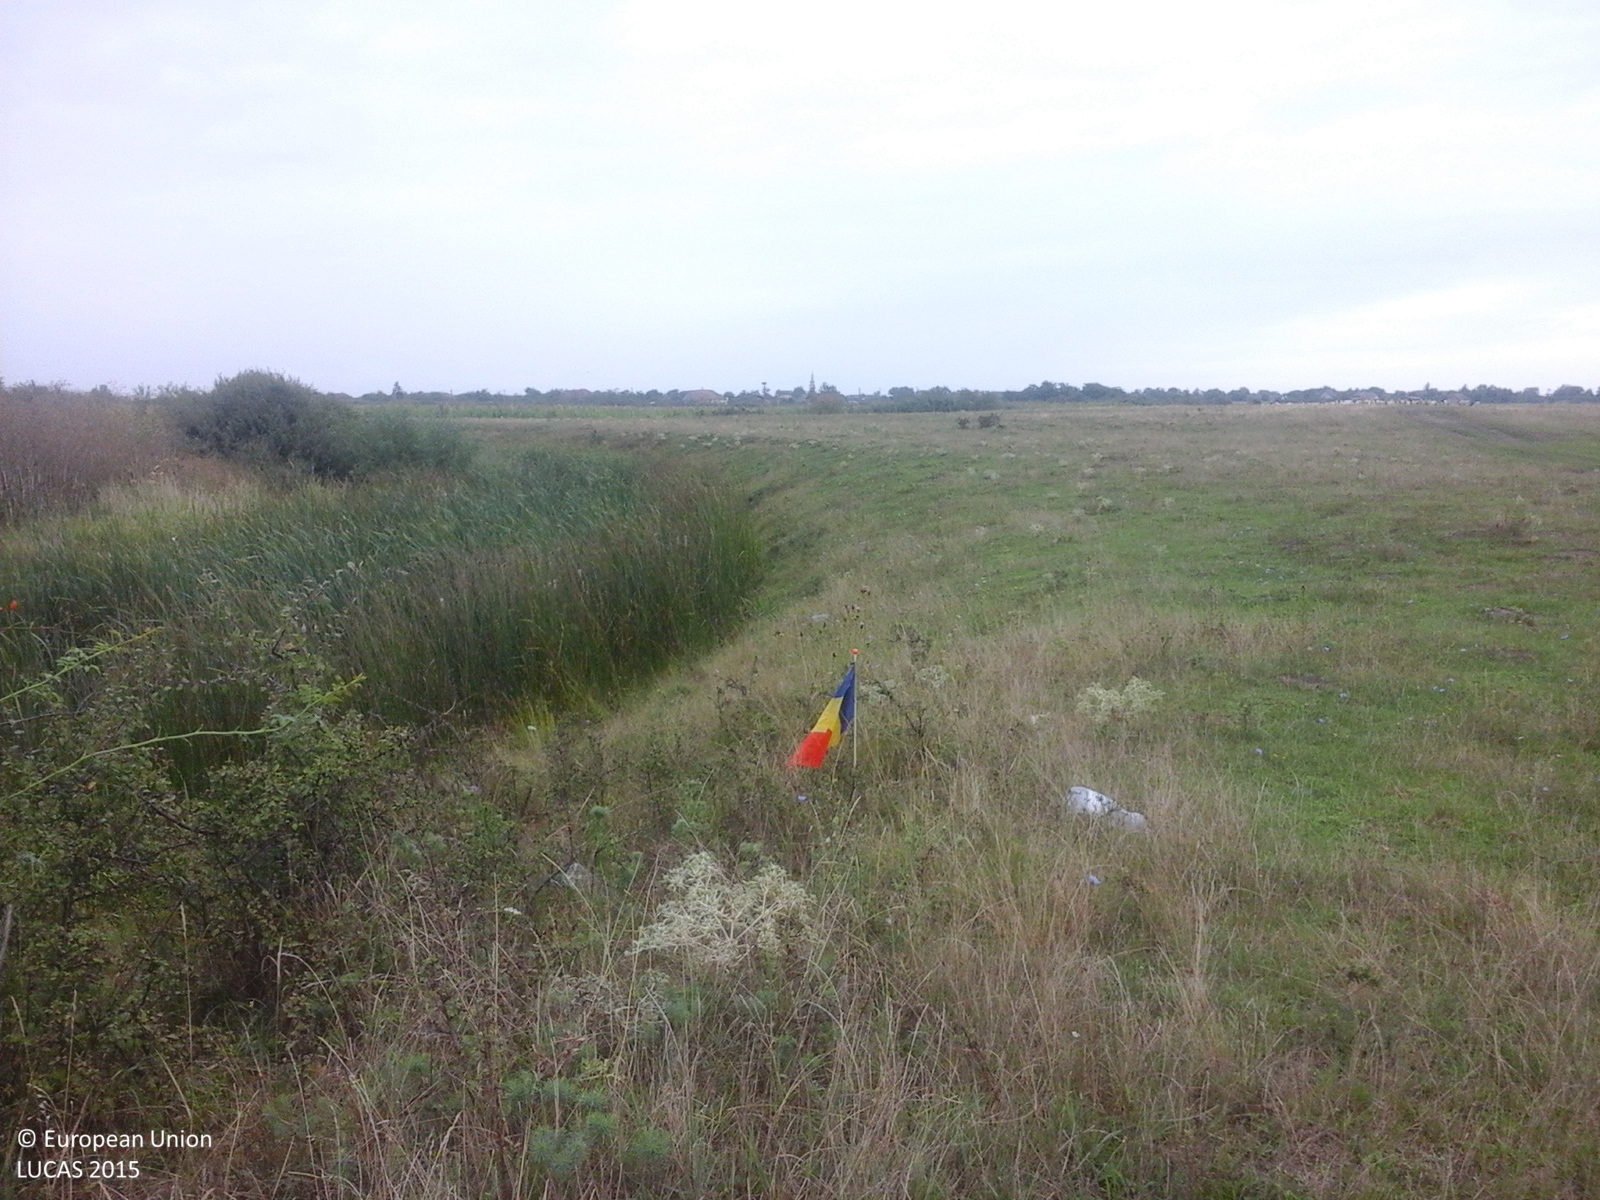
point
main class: Grassland
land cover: Grassland without tree/shrub cover
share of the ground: > 75 %
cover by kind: herbaceous plants 100 %
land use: Agriculture (excluding fallow land and kitchen gardens)
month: August
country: RO
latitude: 45.4057
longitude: 20.9493
